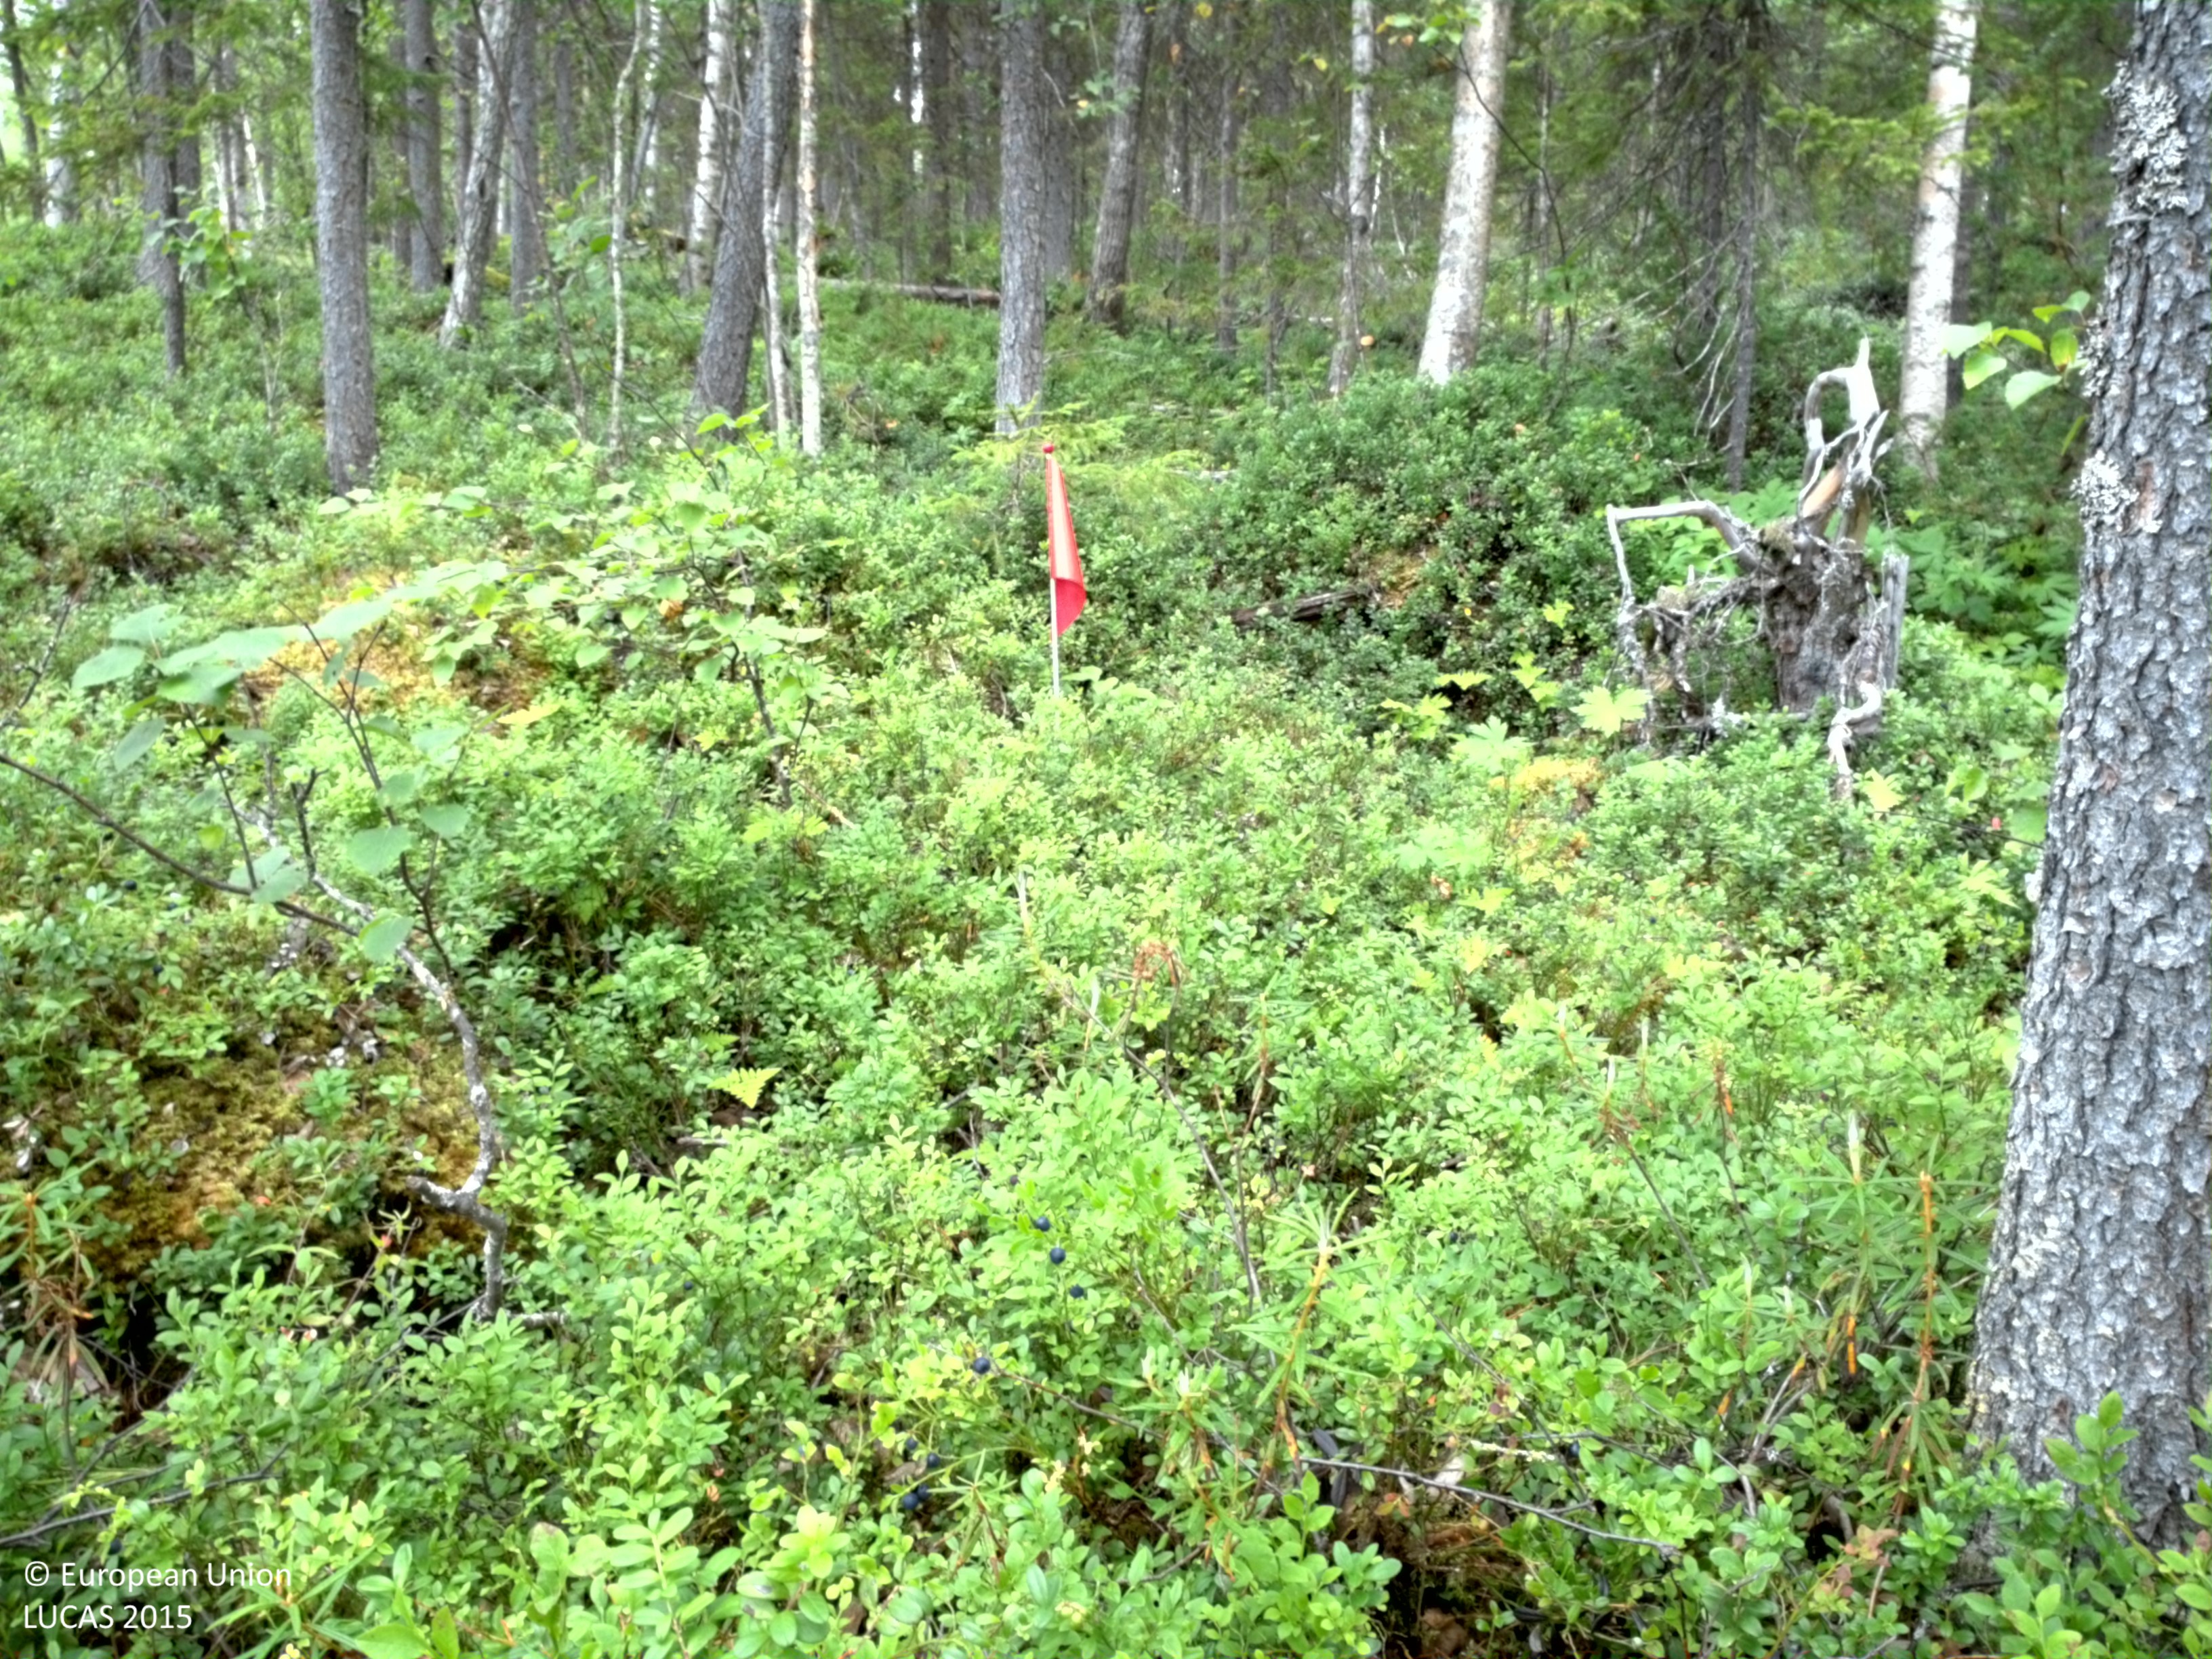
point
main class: Woodland
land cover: Spruce dominated mixed woodland
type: boreal forest
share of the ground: 50 - 75 %
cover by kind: shrubs 40 %, coniferous forest trees 35 %, broadleaved forest trees 25 %
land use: Forestry
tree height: > 5 m
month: August
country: SE
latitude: 66.2986
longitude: 20.4588
